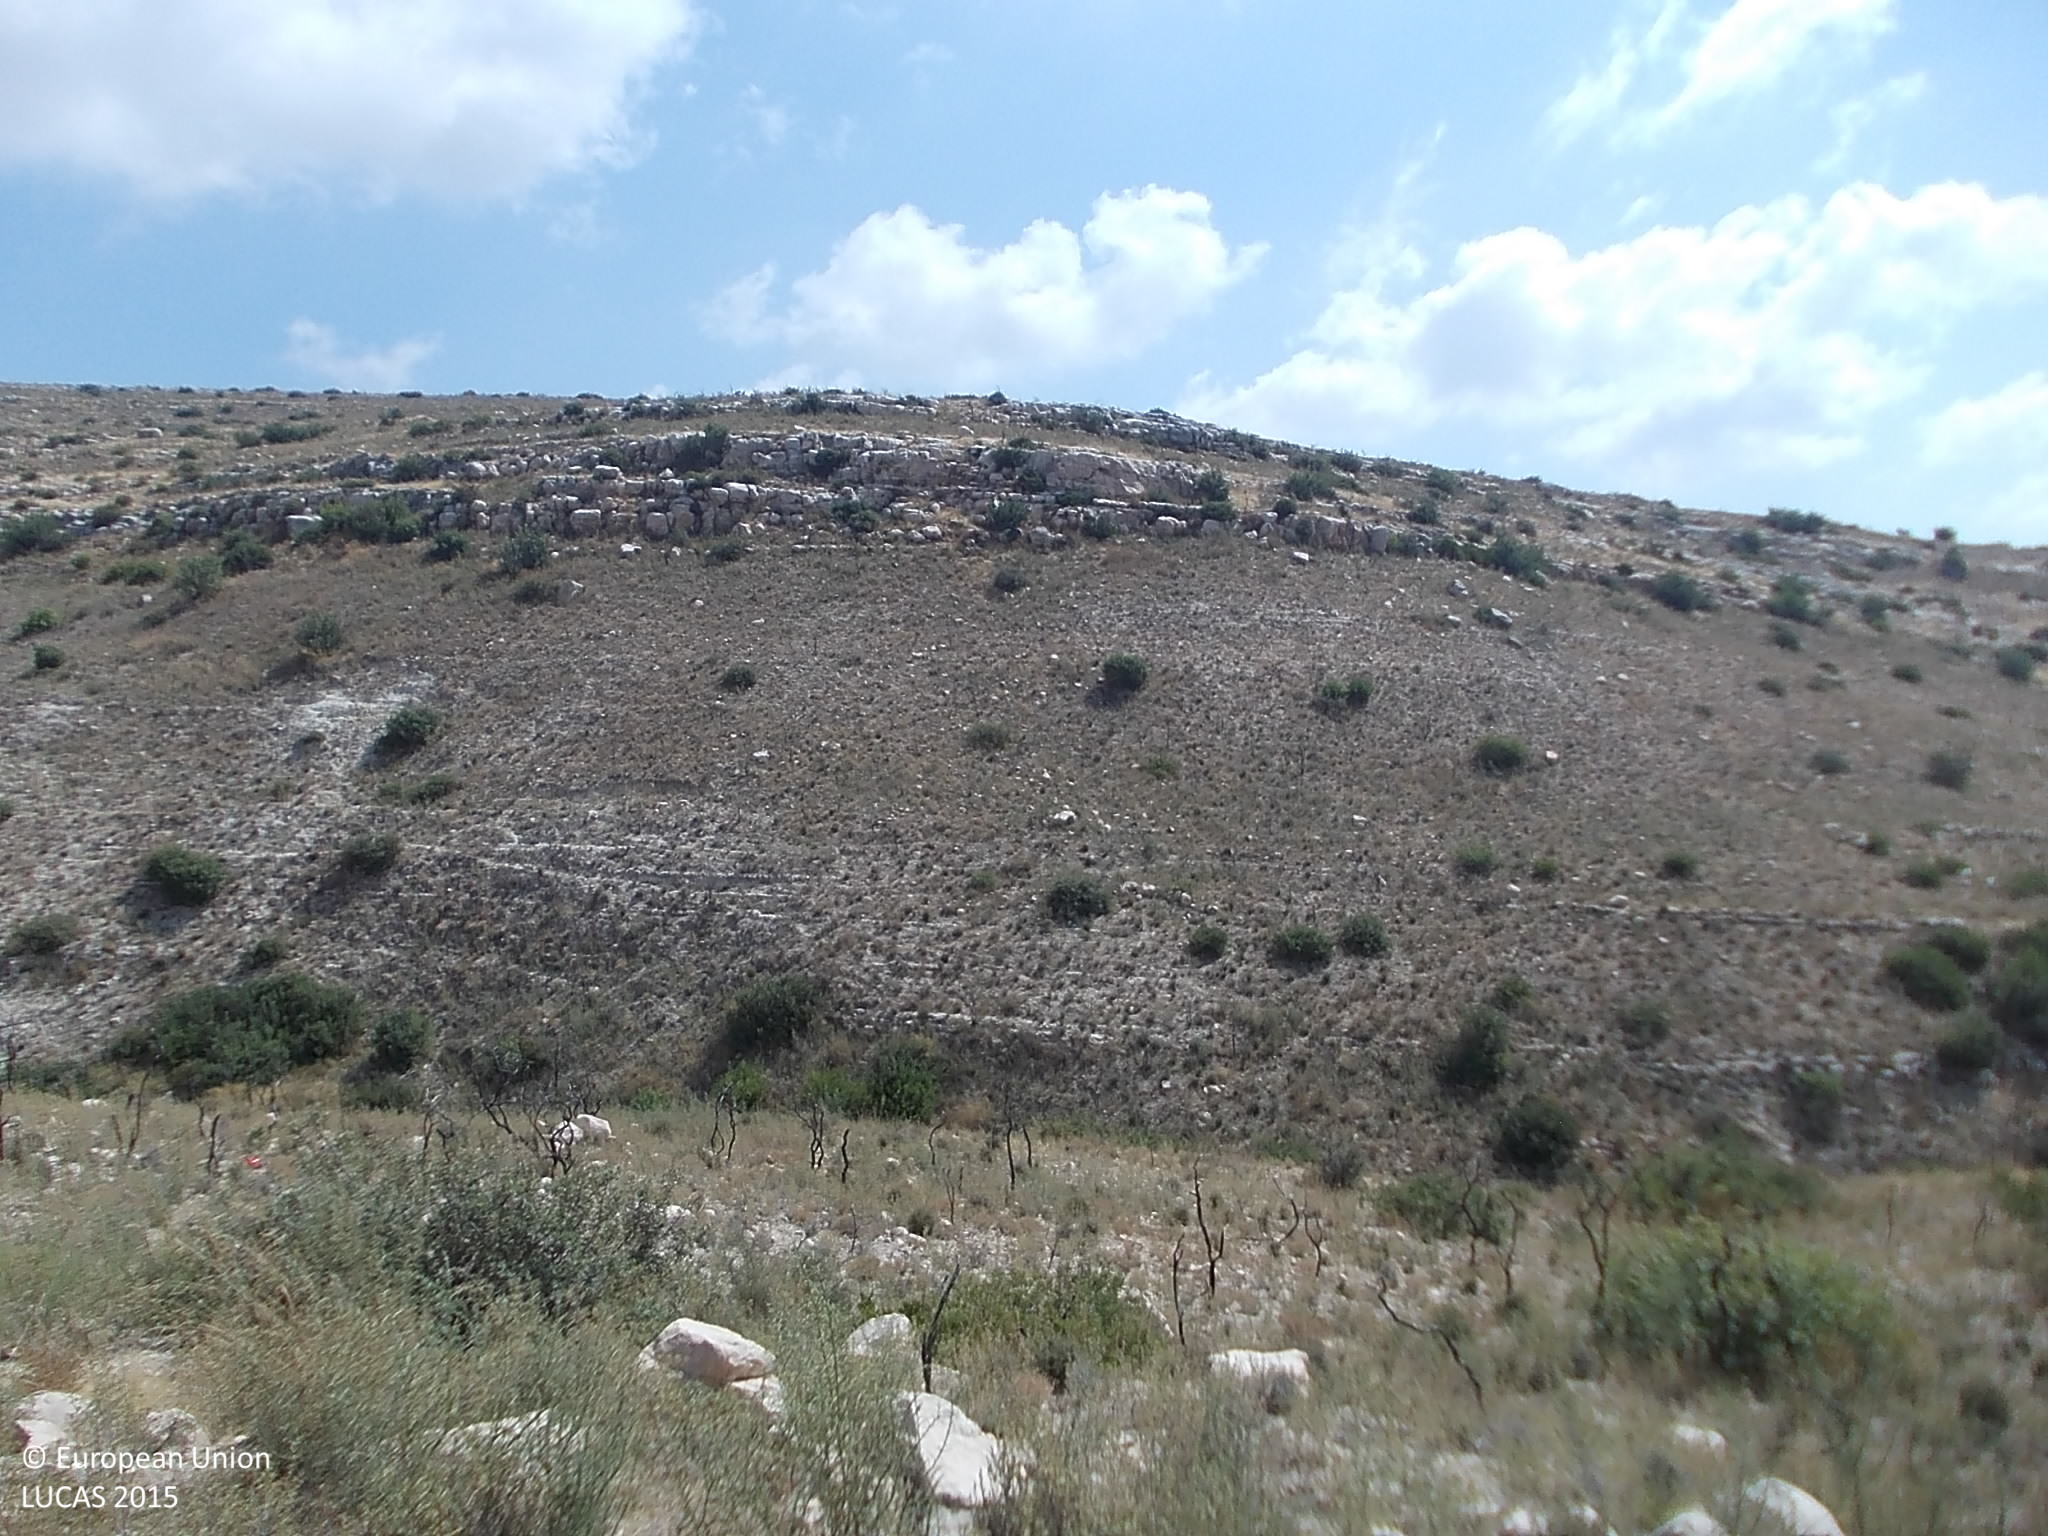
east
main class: Shrubland
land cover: Shrubland without tree cover
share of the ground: 25 - 50 %
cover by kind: shrubs 45 %, herbaceous plants 30 %, unconsolidated bare surface 20 %, consolidated bare surface 5 %
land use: Semi-natural and natural areas not in use
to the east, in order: Shrubland without tree cover; Inland fresh running water; Shrubland without tree cover; Rocks and stones; Shrubland without tree cover; Tracks; Shrubland without tree cover
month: September
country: CY
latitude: 34.7118
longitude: 32.8812
